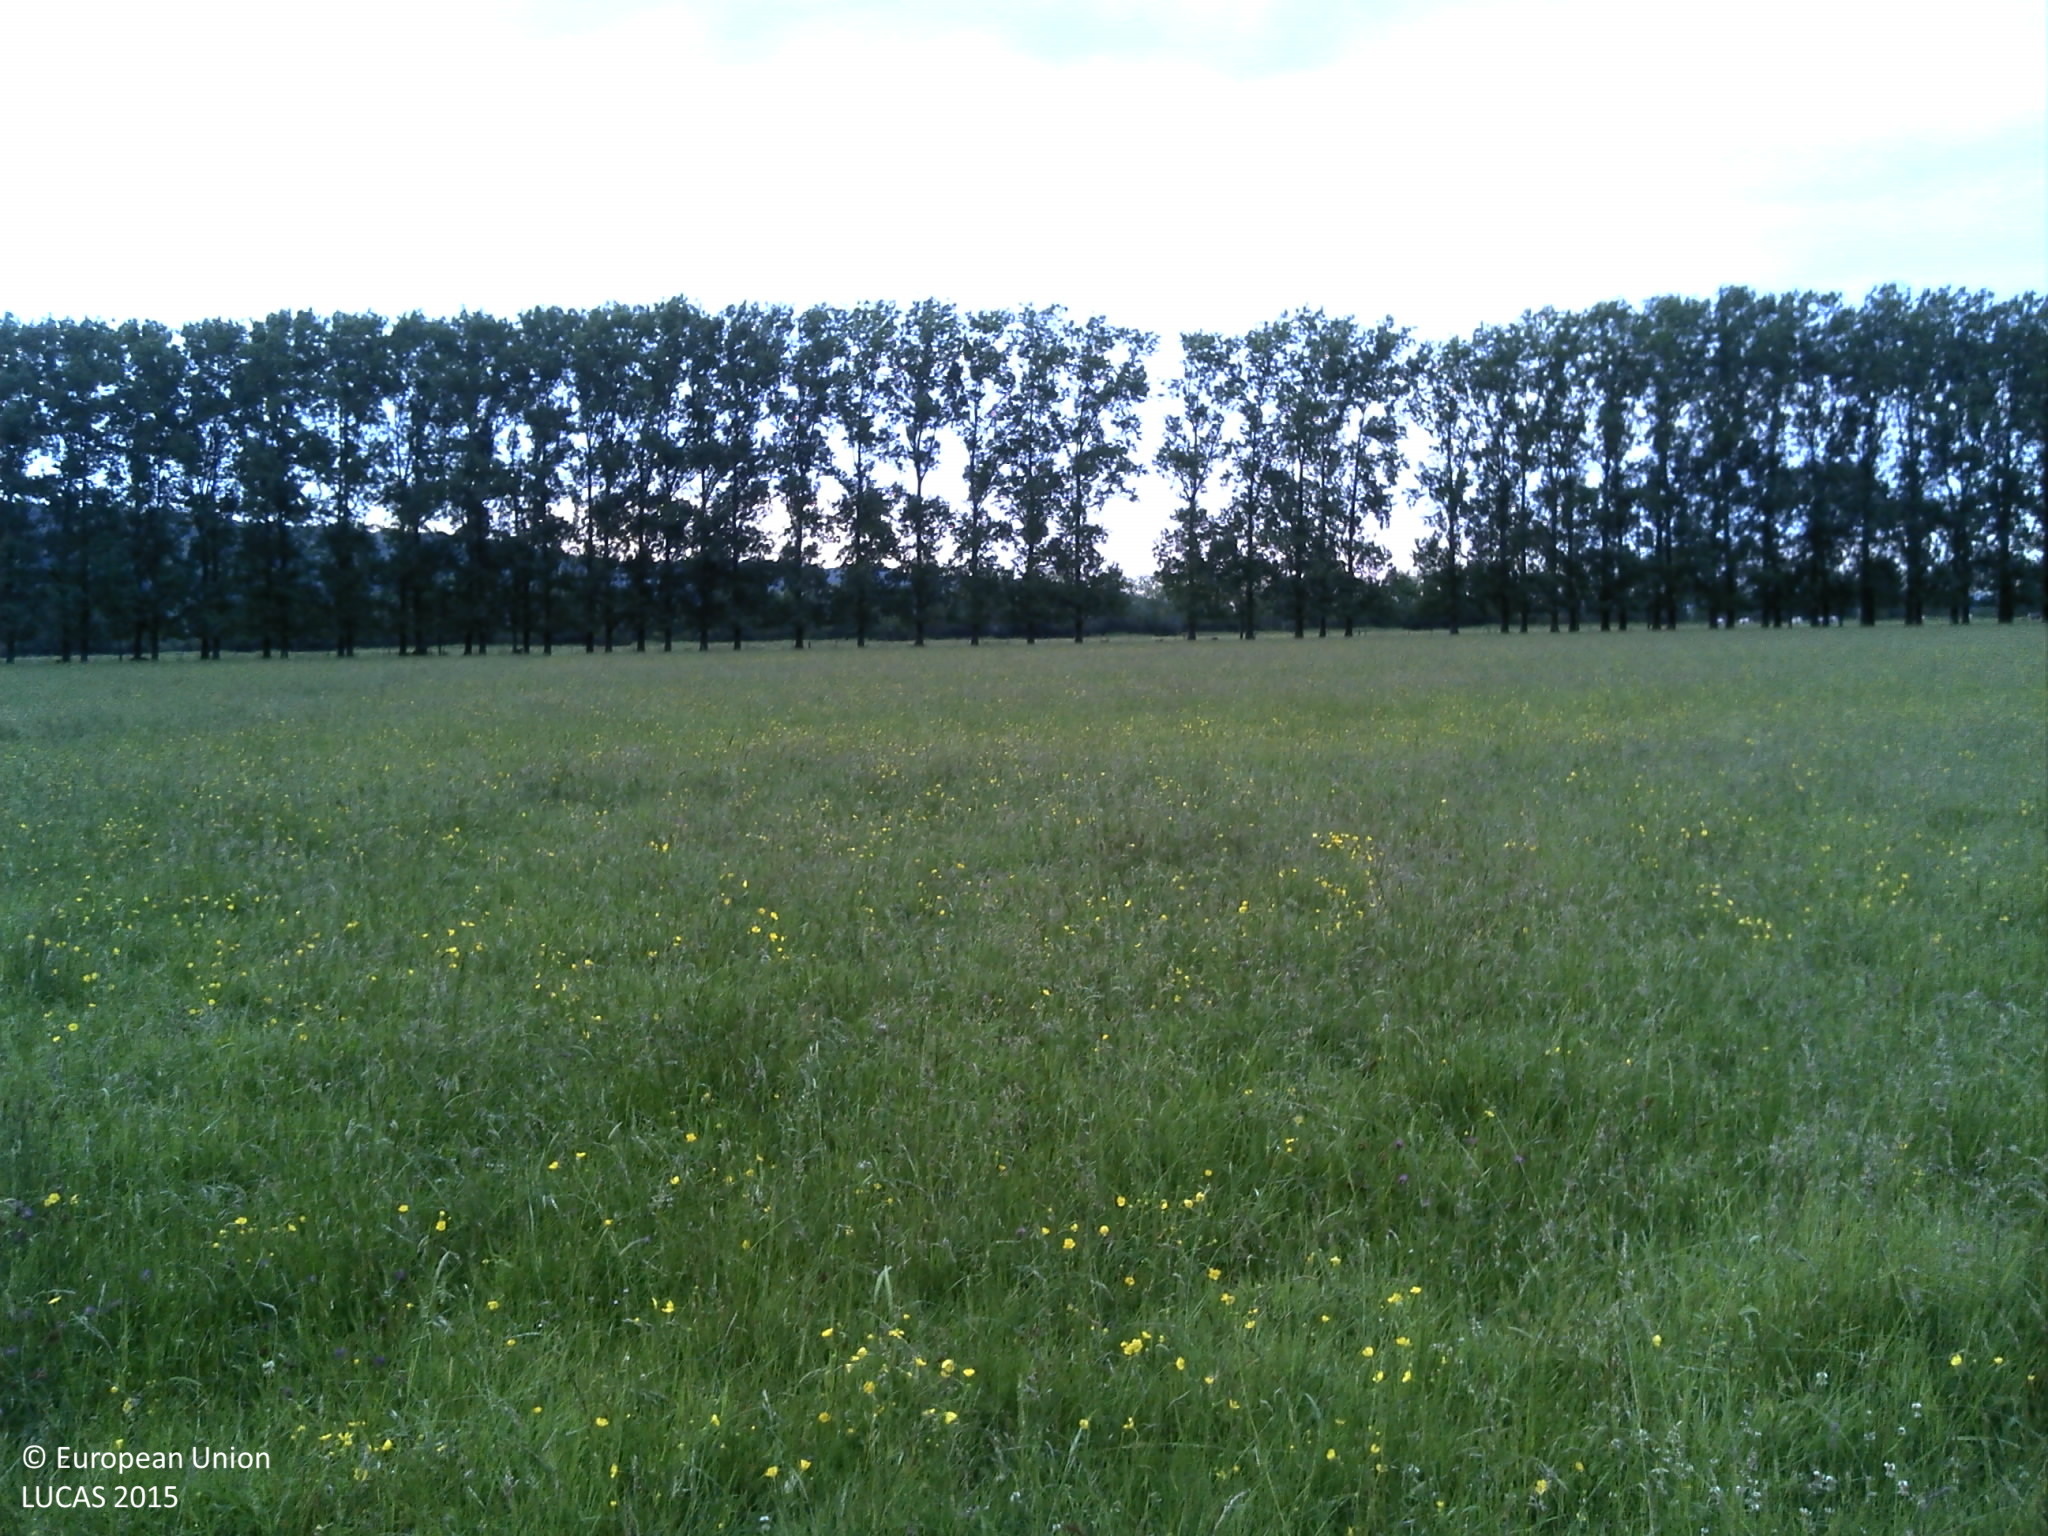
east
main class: Grassland
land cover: Grassland without tree/shrub cover
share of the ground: > 75 %
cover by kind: herbaceous plants 100 %
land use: Agriculture (excluding fallow land and kitchen gardens)
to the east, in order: Grassland without tree/shrub cover; Fences; Lines of trees; Grassland without tree/shrub cover
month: June
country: FR
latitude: 49.4890
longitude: 0.4057
